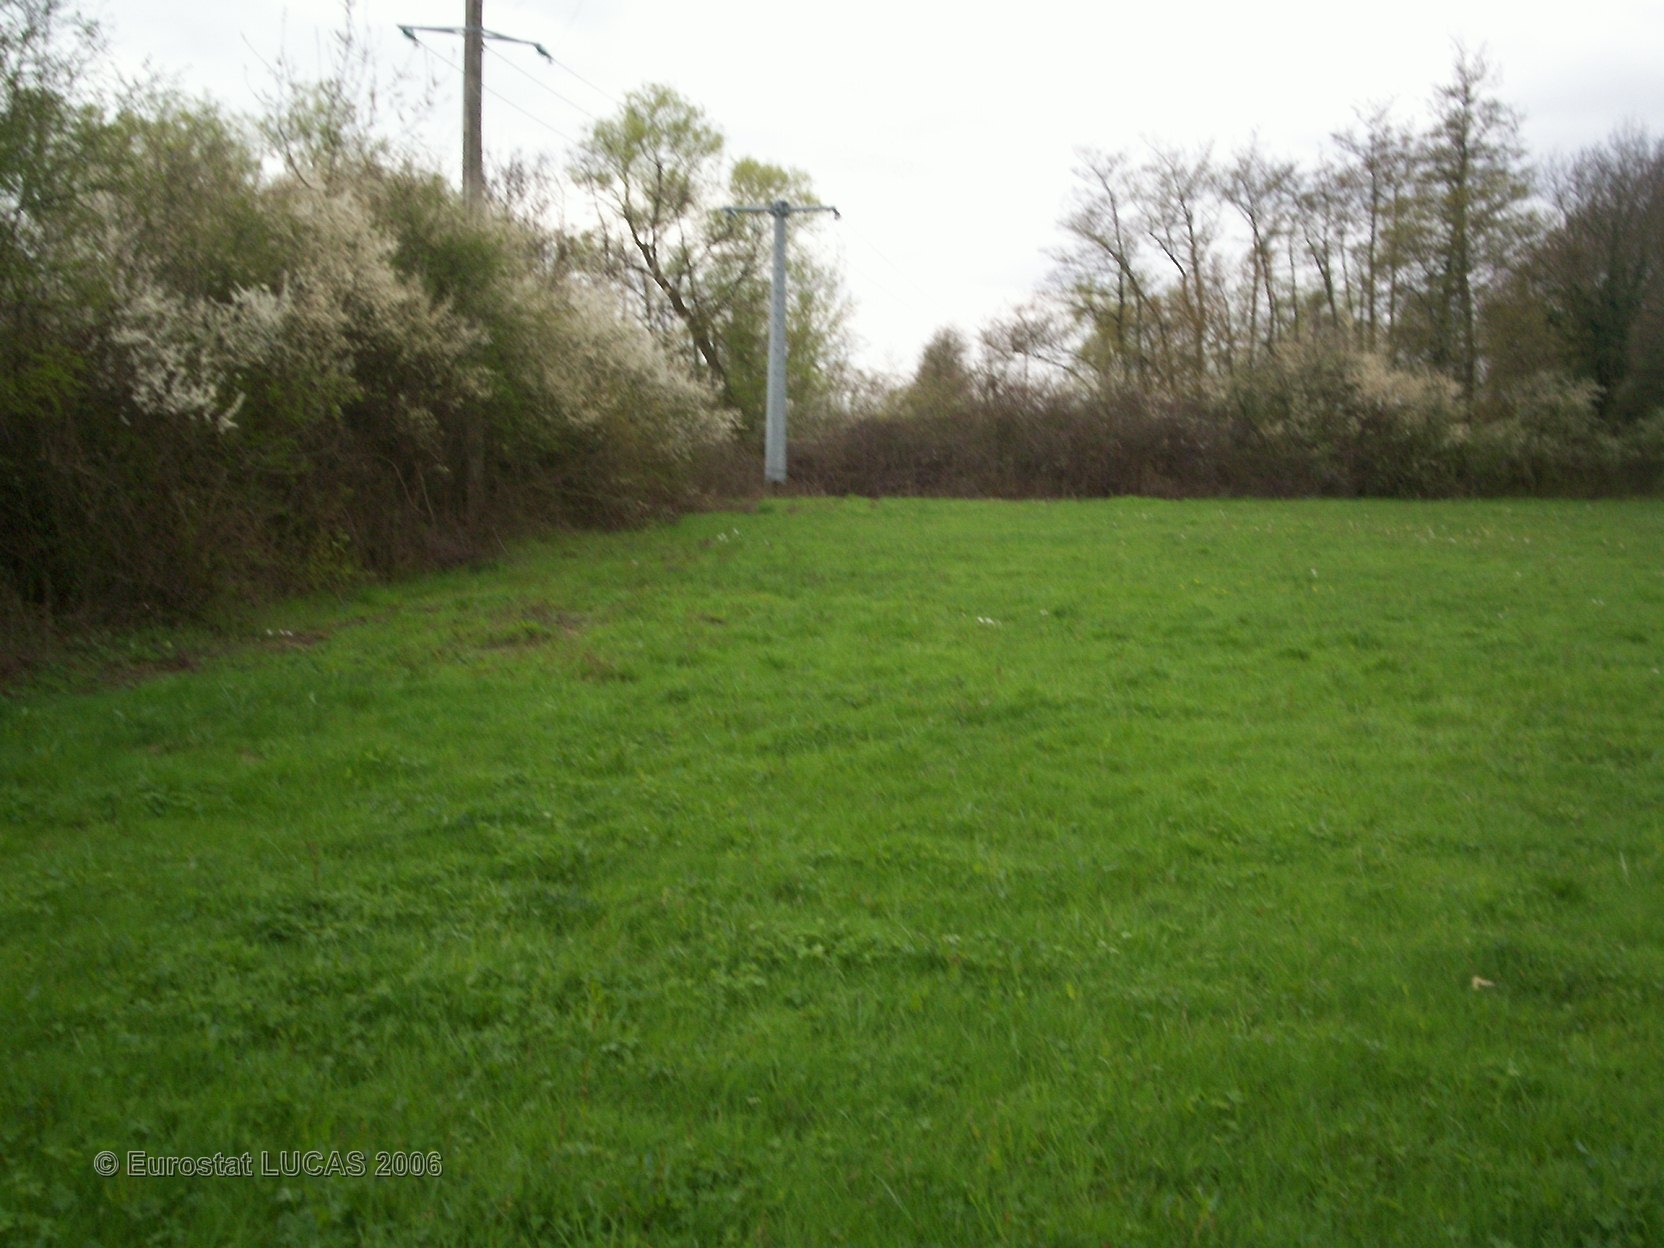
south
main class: Grassland
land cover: Grassland without tree/shrub cover
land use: Agriculture (excluding fallow land and kitchen gardens)
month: April
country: FR
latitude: 46.2044
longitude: 4.7535
